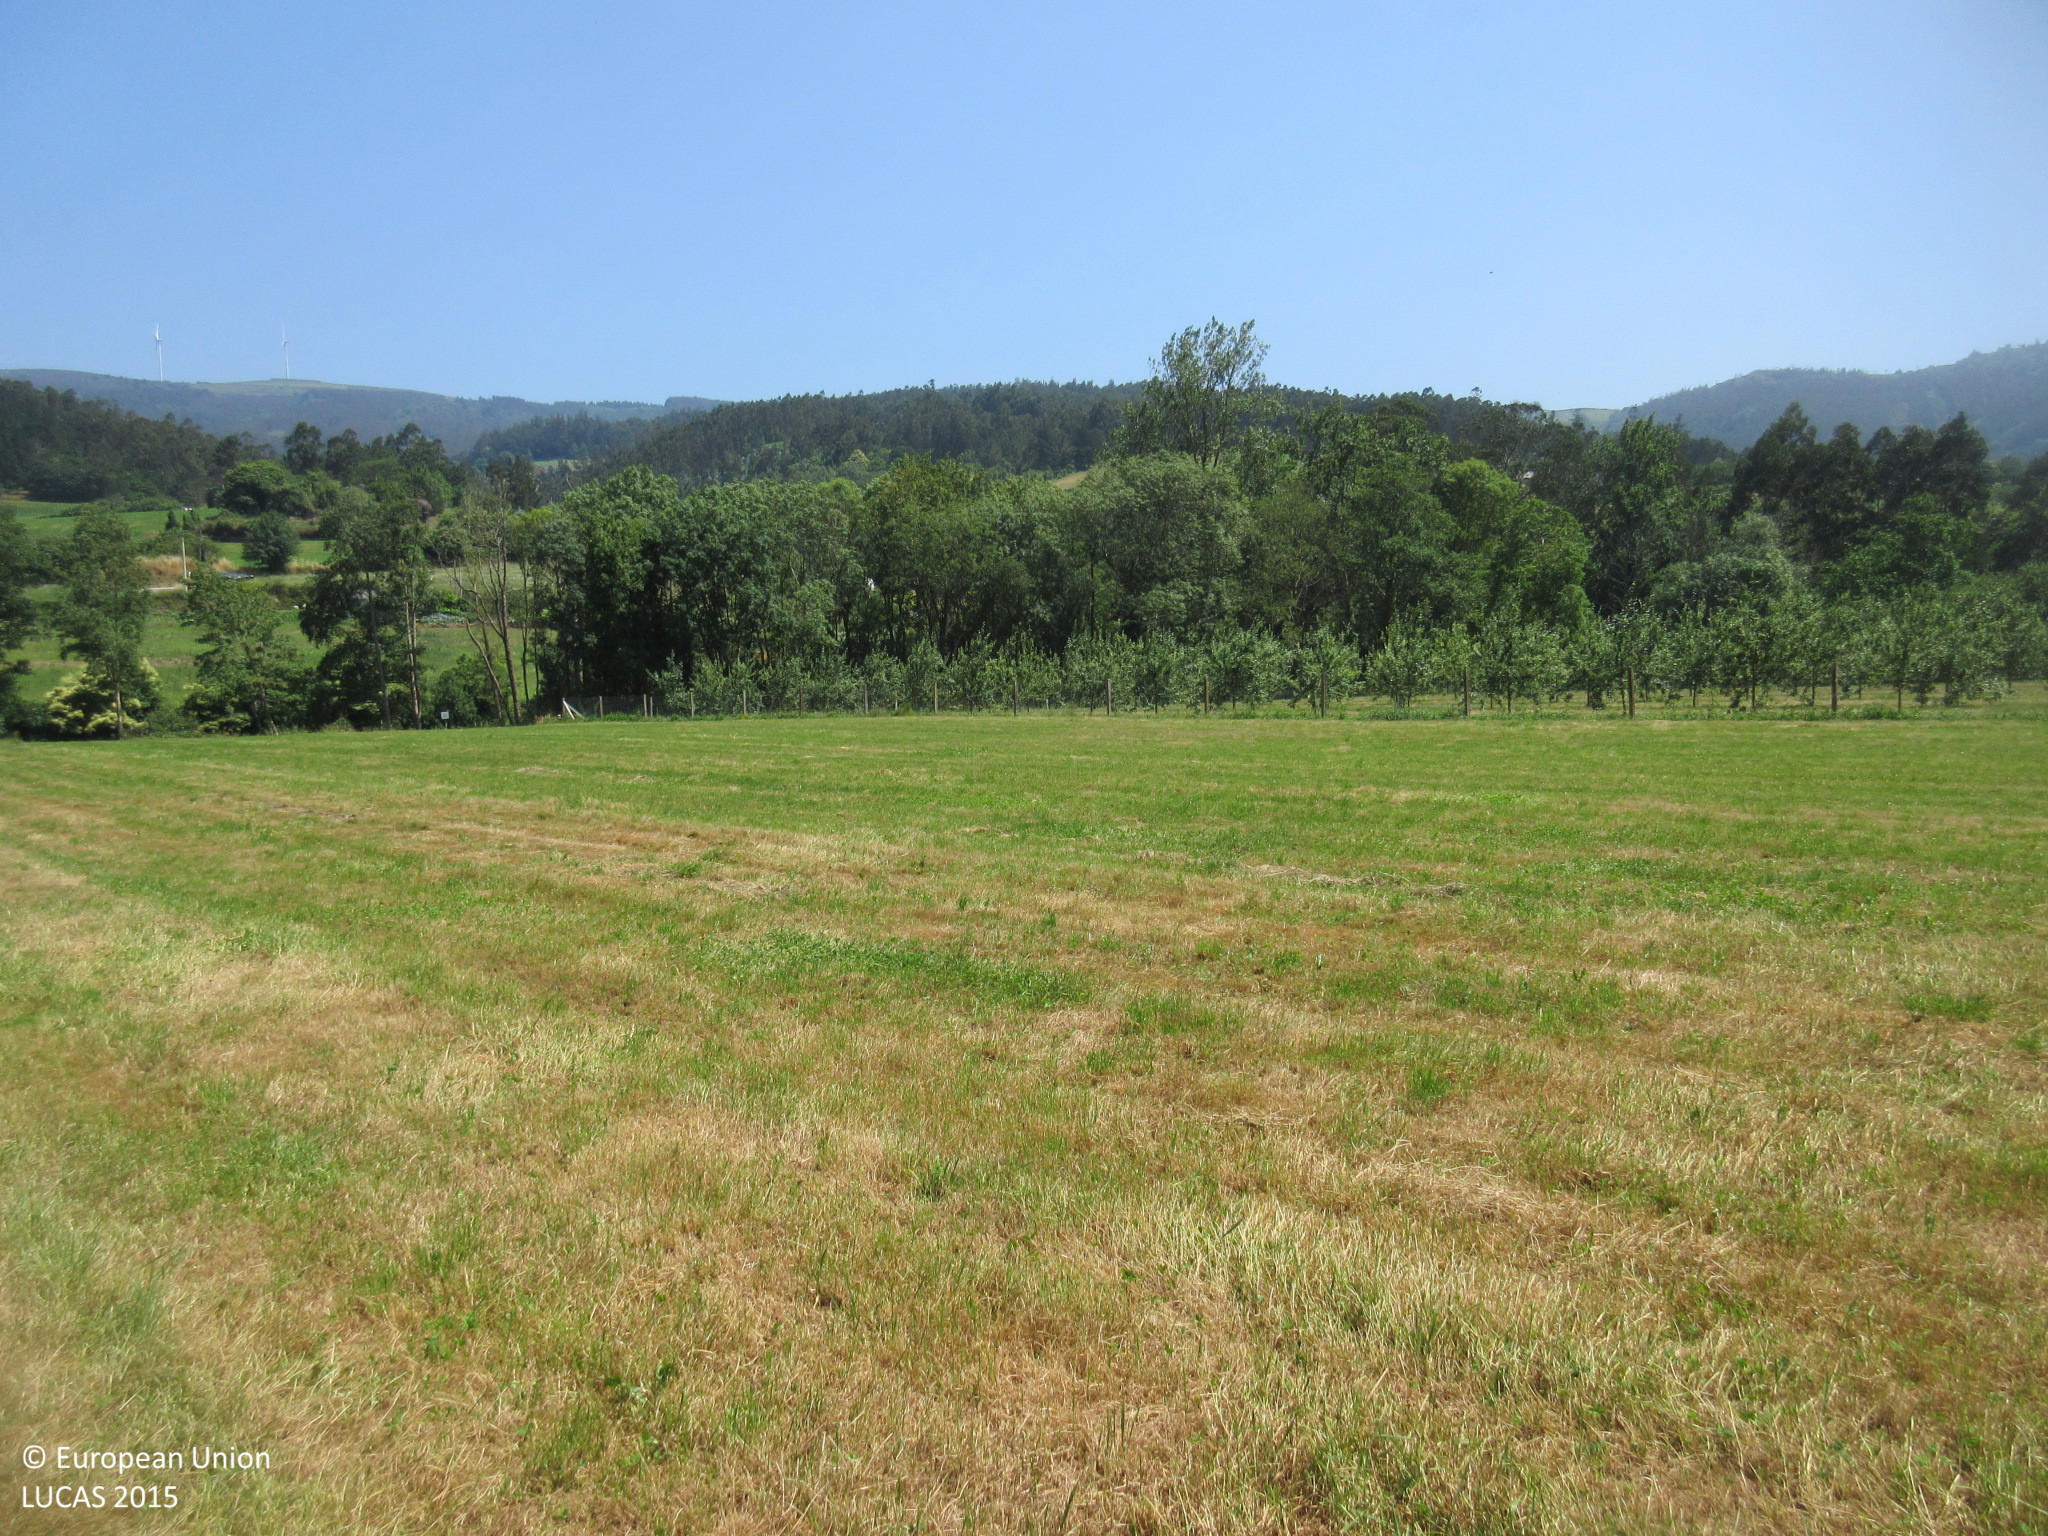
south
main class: Grassland
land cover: Grassland without tree/shrub cover
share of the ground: > 75 %
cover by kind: herbaceous plants 100 %
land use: Agriculture (excluding fallow land and kitchen gardens)
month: June
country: ES
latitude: 43.4069
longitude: -7.1488
